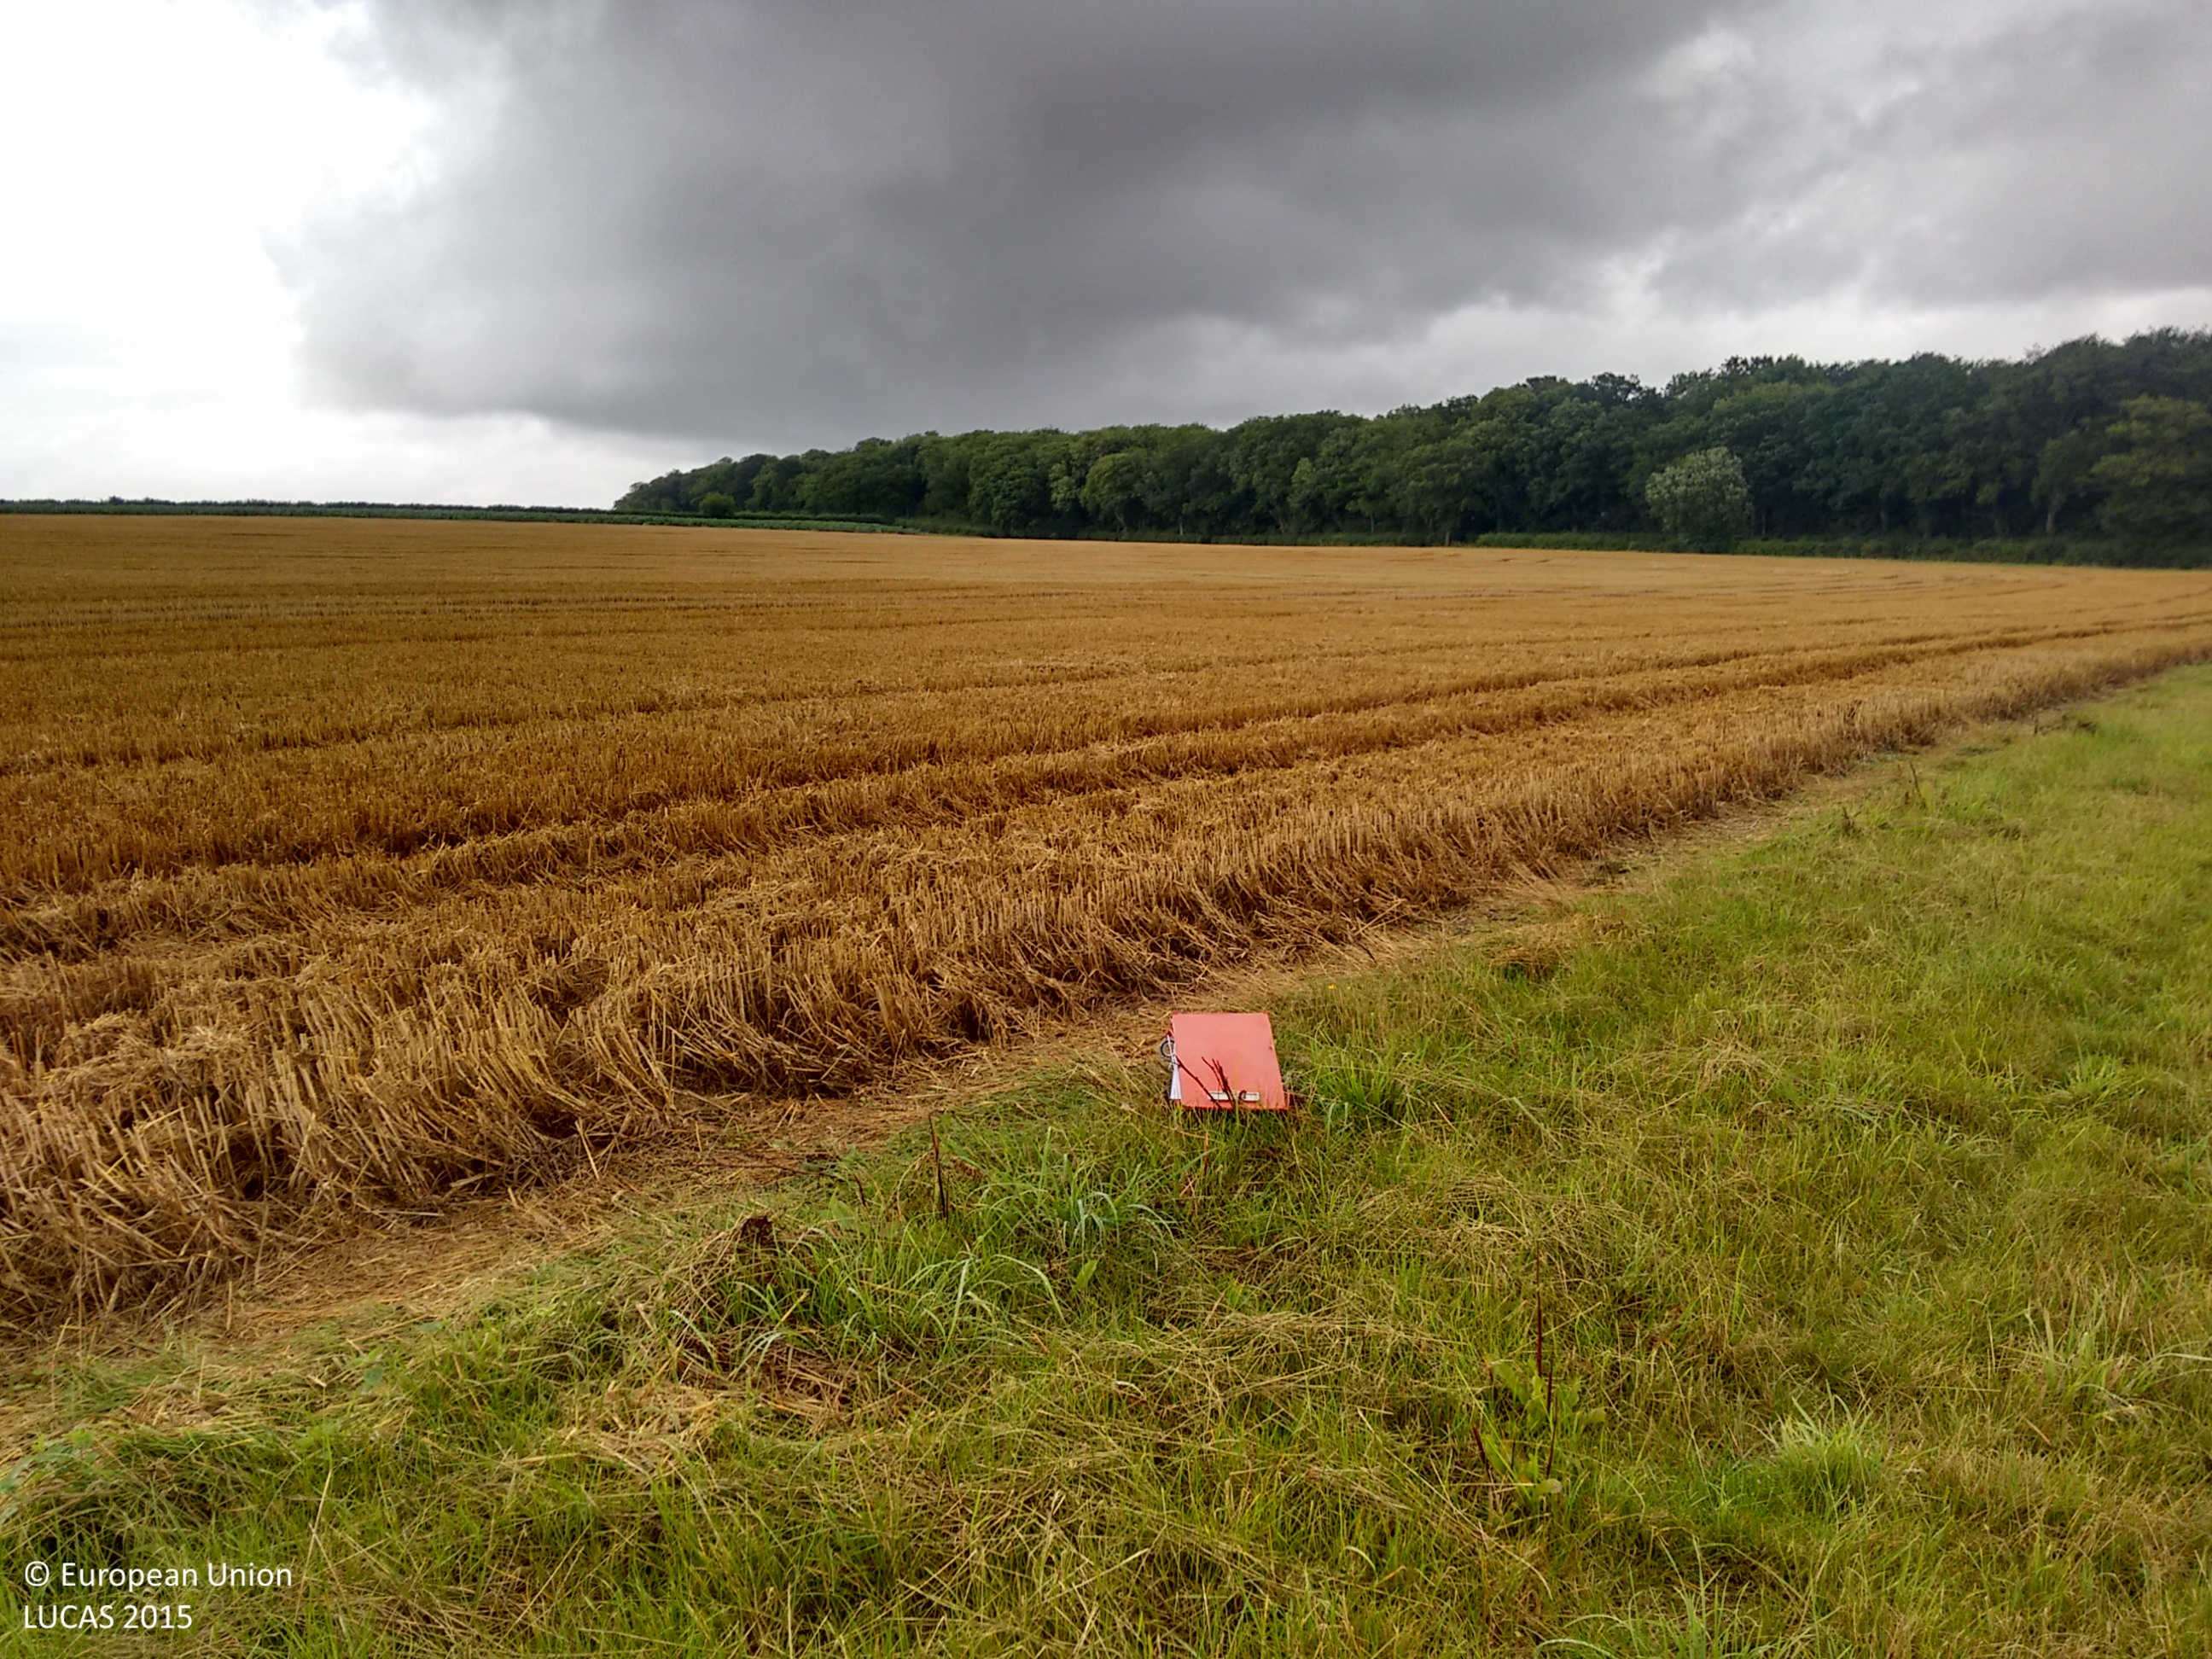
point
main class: Cropland
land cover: Common wheat
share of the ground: > 75 %
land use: Agriculture (excluding fallow land and kitchen gardens)
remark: Harvested field
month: August
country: GB
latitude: 52.1196
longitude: 0.4642
